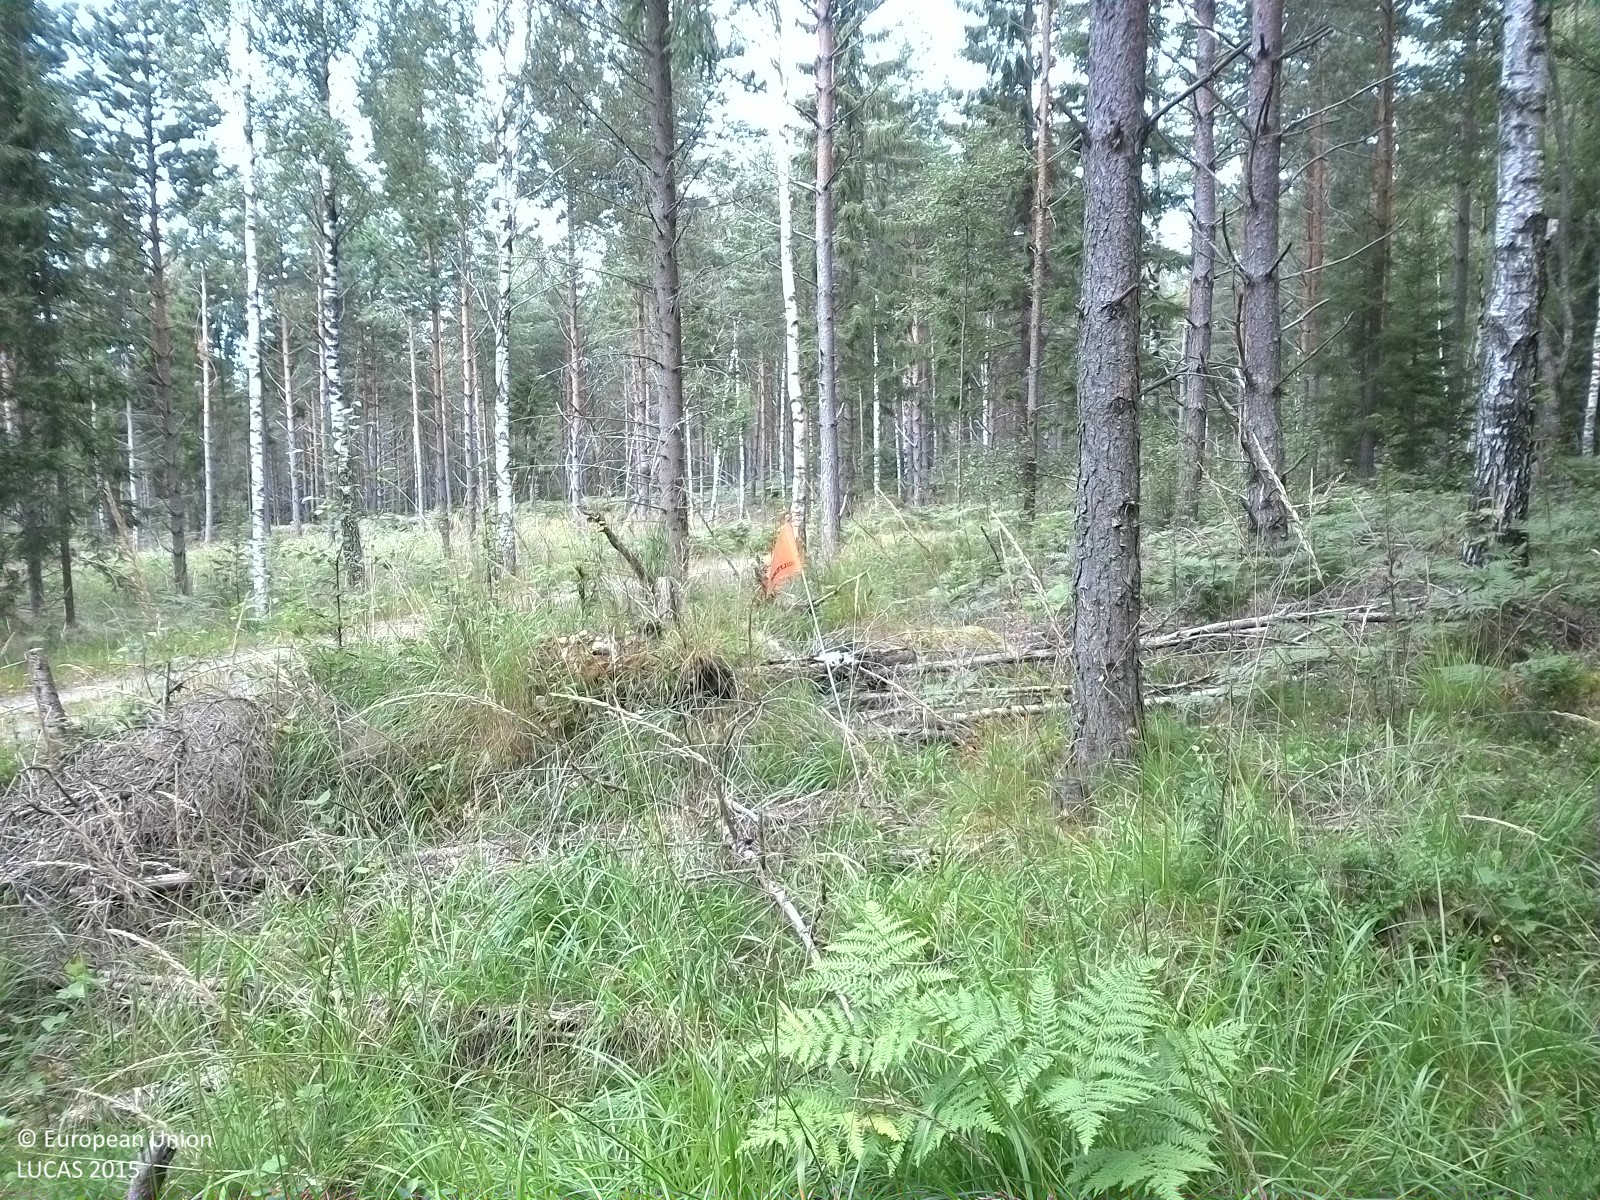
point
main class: Woodland
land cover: Pine dominated mixed woodland
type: boreal forest
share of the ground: 25 - 50 %
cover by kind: herbaceous plants 65 %, coniferous forest trees 20 %, broadleaved forest trees 10 %, lichens and mosses 5 %
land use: Forestry
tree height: > 5 m
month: August
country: SE
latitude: 59.0218
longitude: 15.1656
